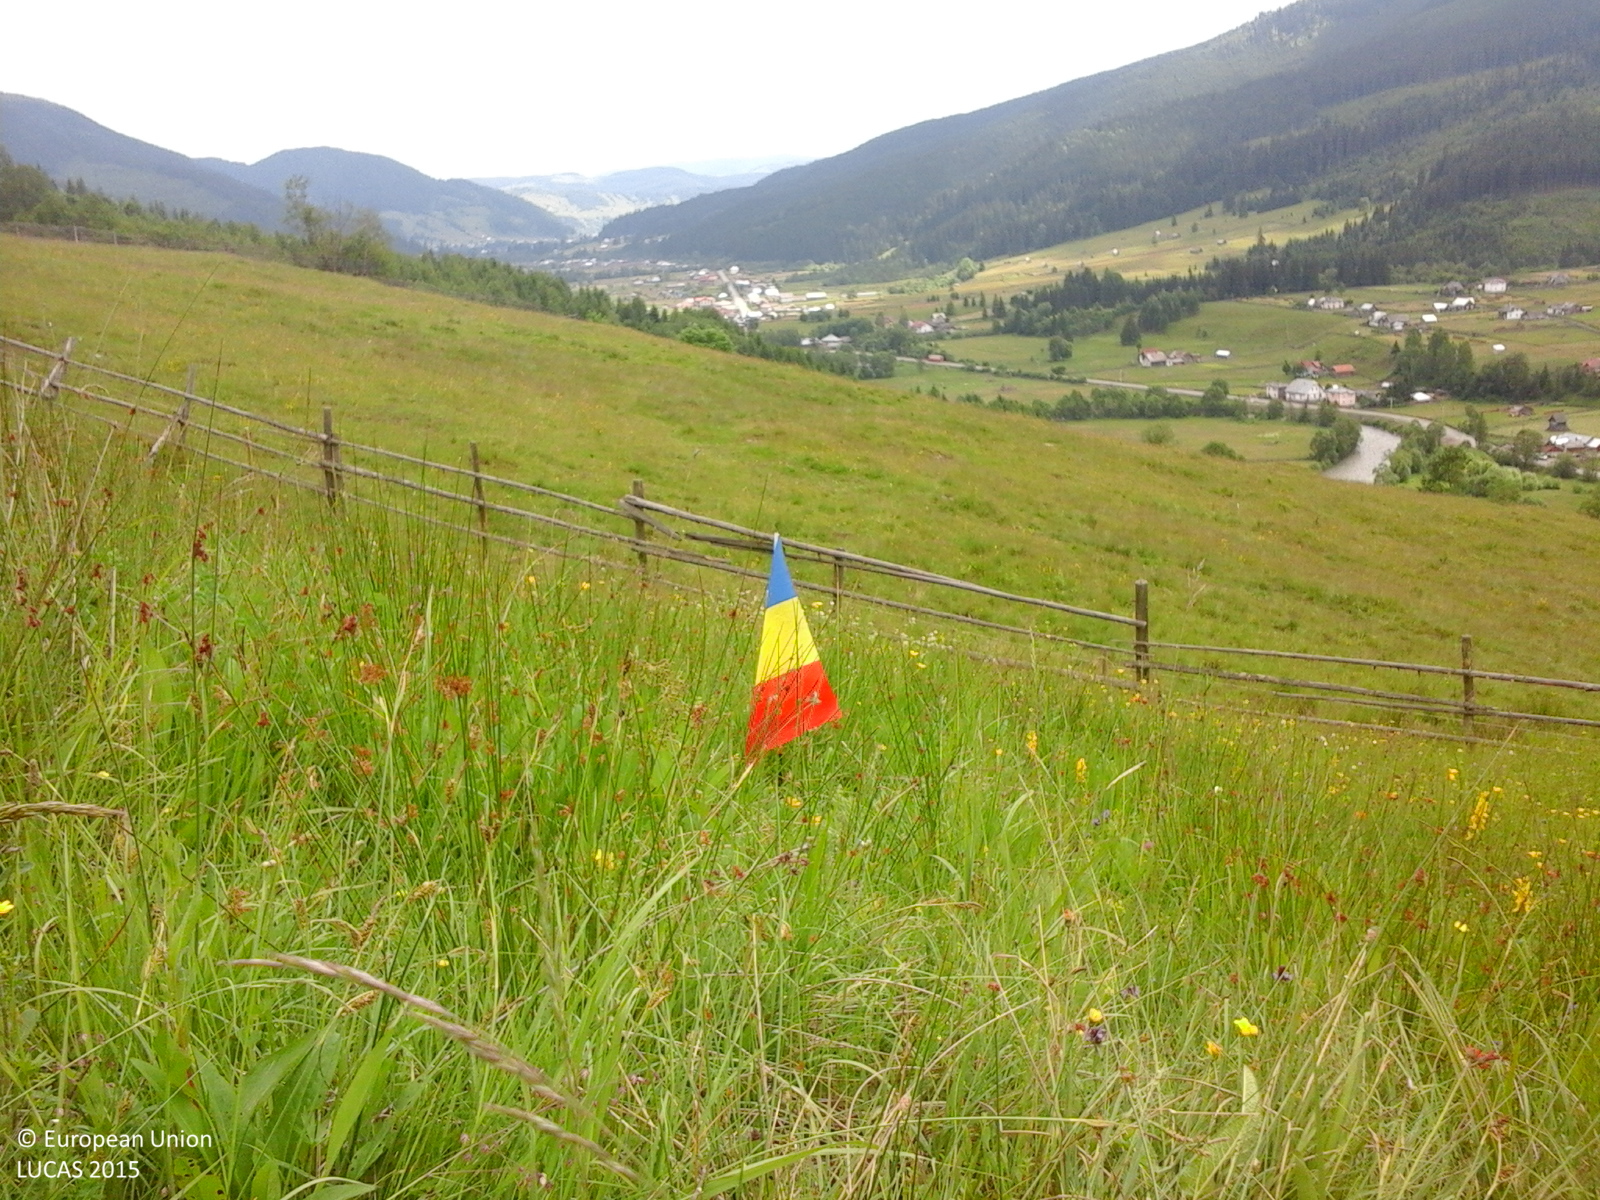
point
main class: Grassland
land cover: Grassland without tree/shrub cover
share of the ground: > 75 %
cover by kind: herbaceous plants 100 %
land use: Agriculture (excluding fallow land and kitchen gardens)
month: June
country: RO
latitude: 47.5262
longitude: 25.2108
